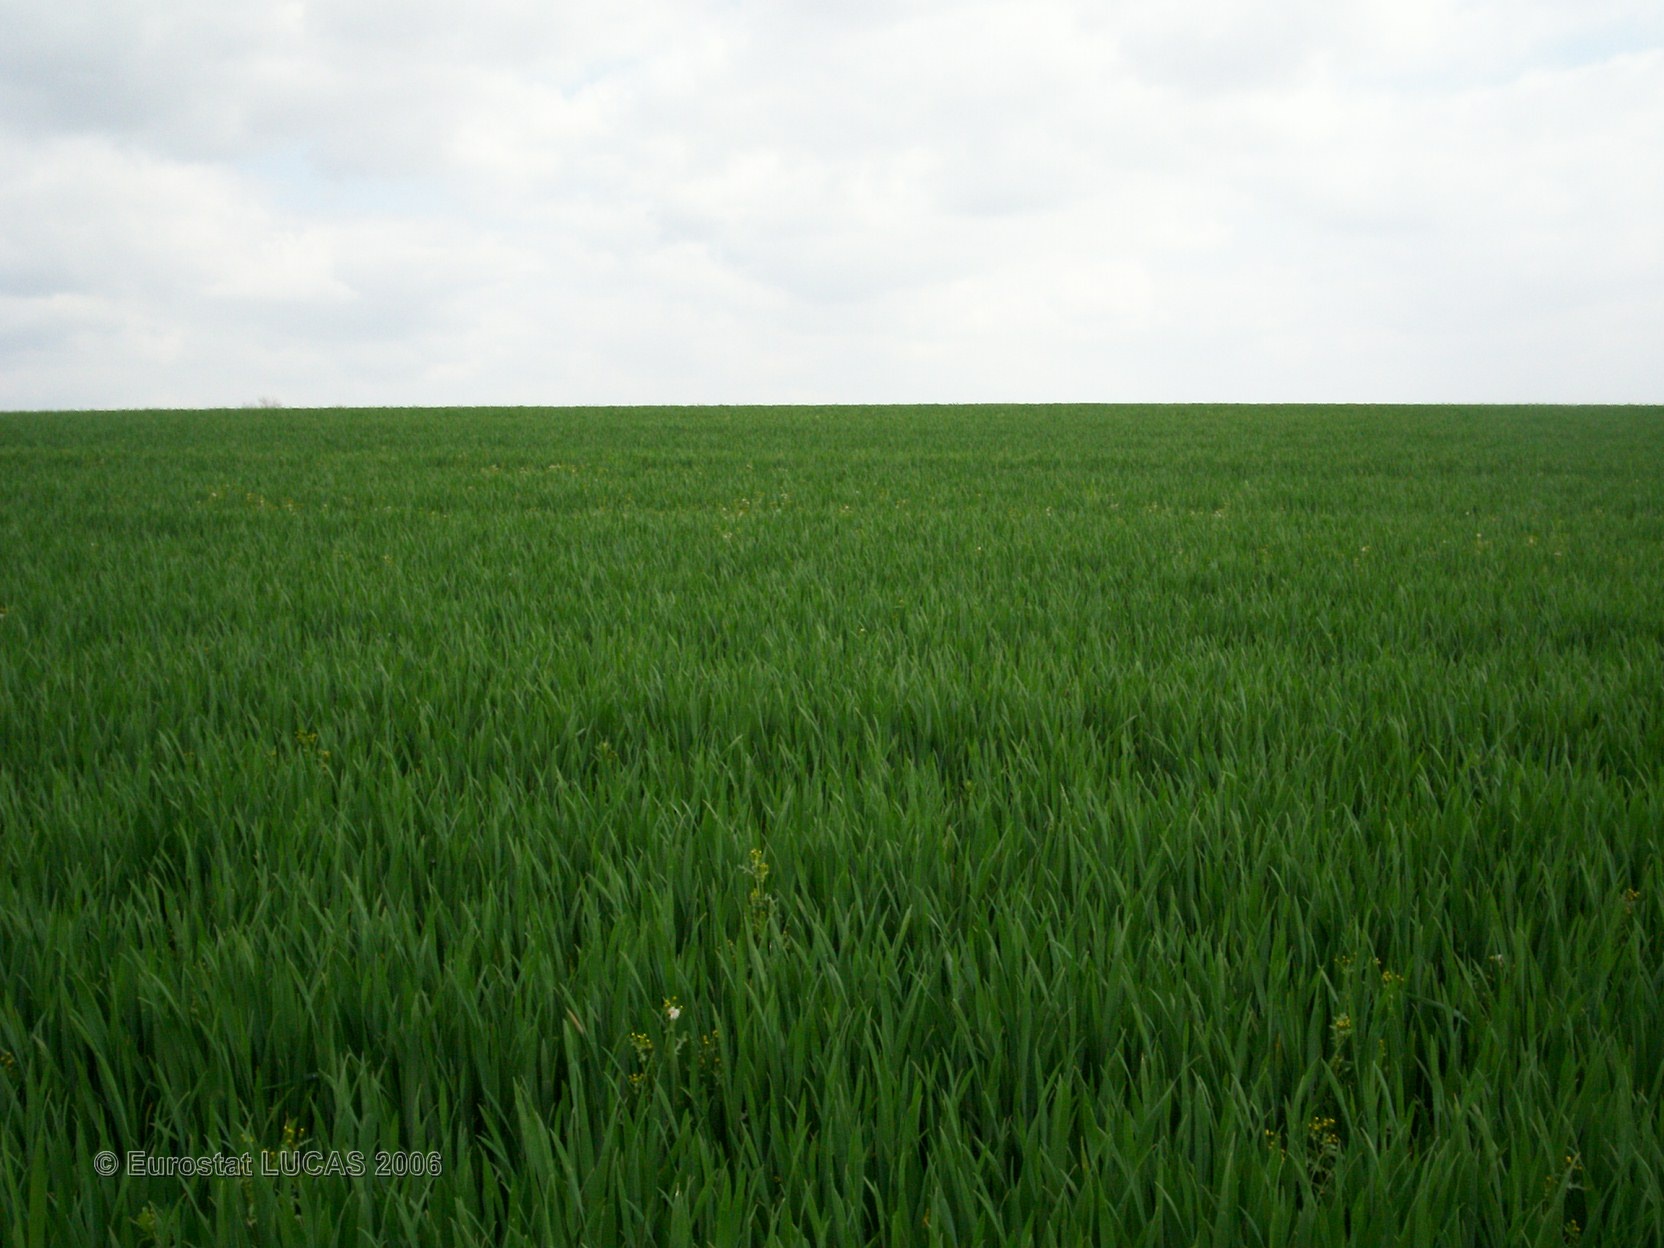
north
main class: Cropland
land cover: Common wheat
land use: Agriculture (excluding fallow land and kitchen gardens)
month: April
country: FR
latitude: 47.0472
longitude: -0.3337
